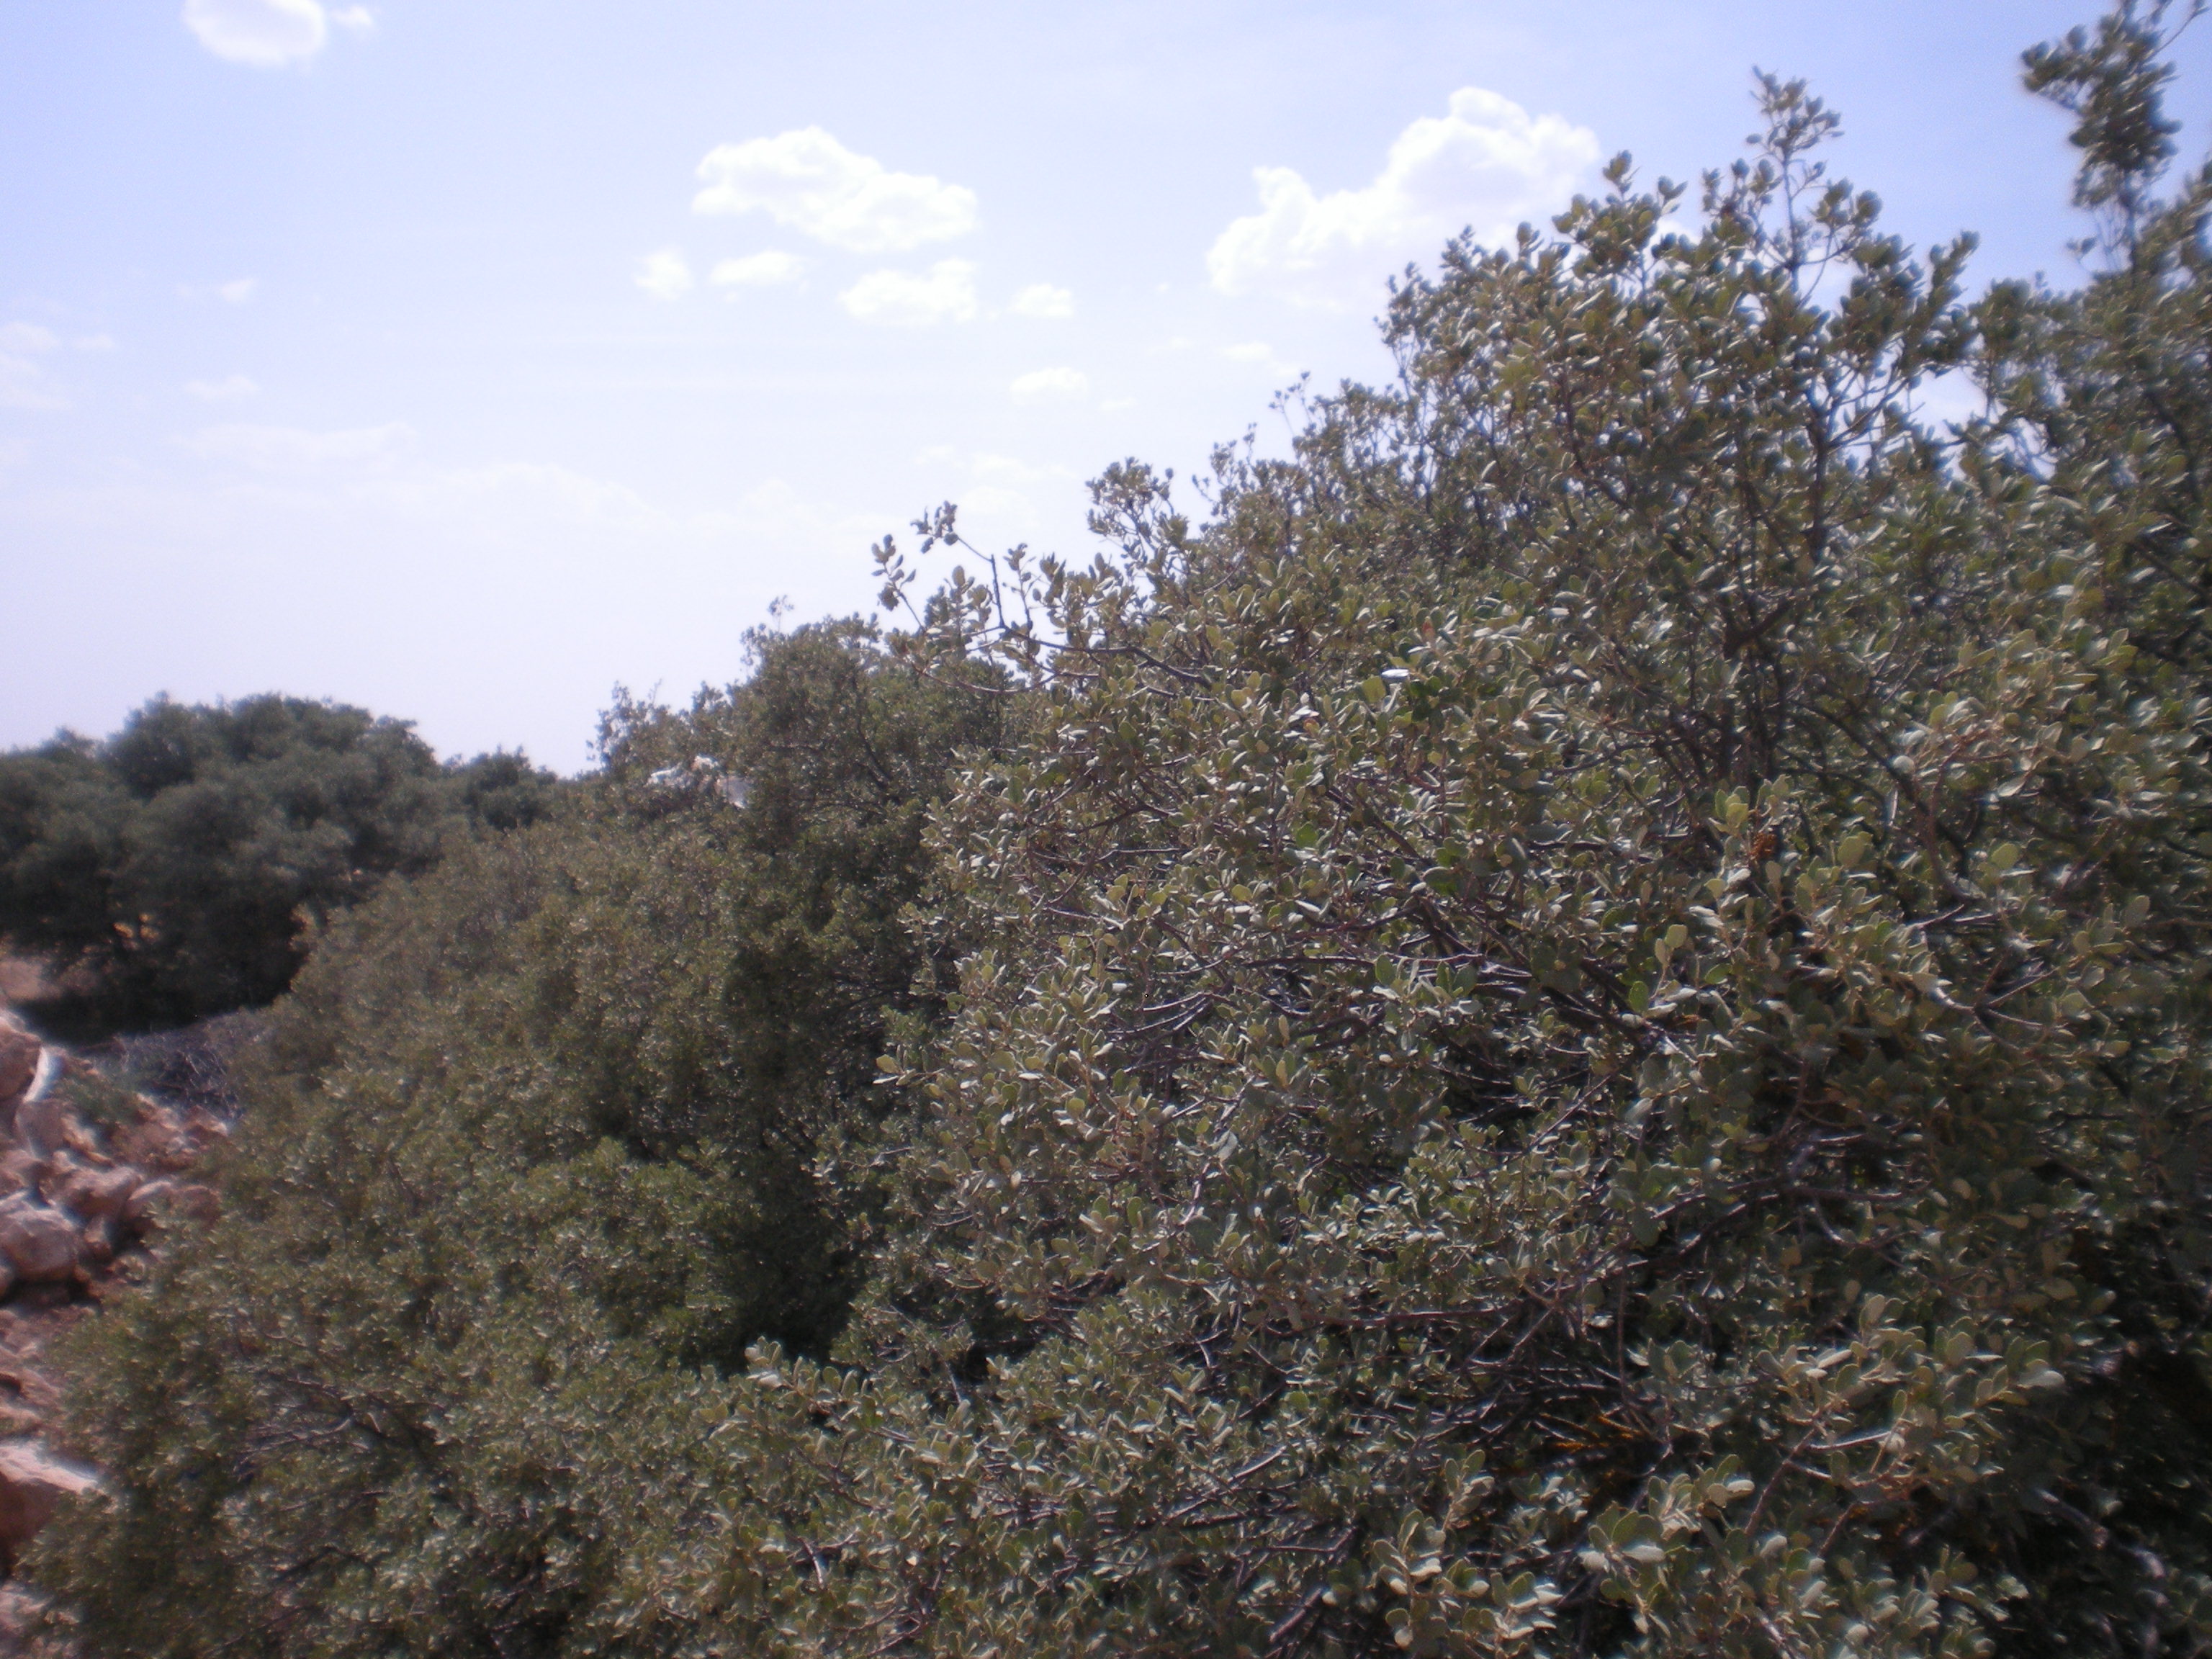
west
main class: Woodland
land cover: Broadleaved woodland
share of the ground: 25 - 50 %
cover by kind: unconsolidated bare surface 65 %, broadleaved forest trees 35 %
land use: Semi-natural and natural areas not in use
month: July
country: ES
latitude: 39.2559
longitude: -3.2389
